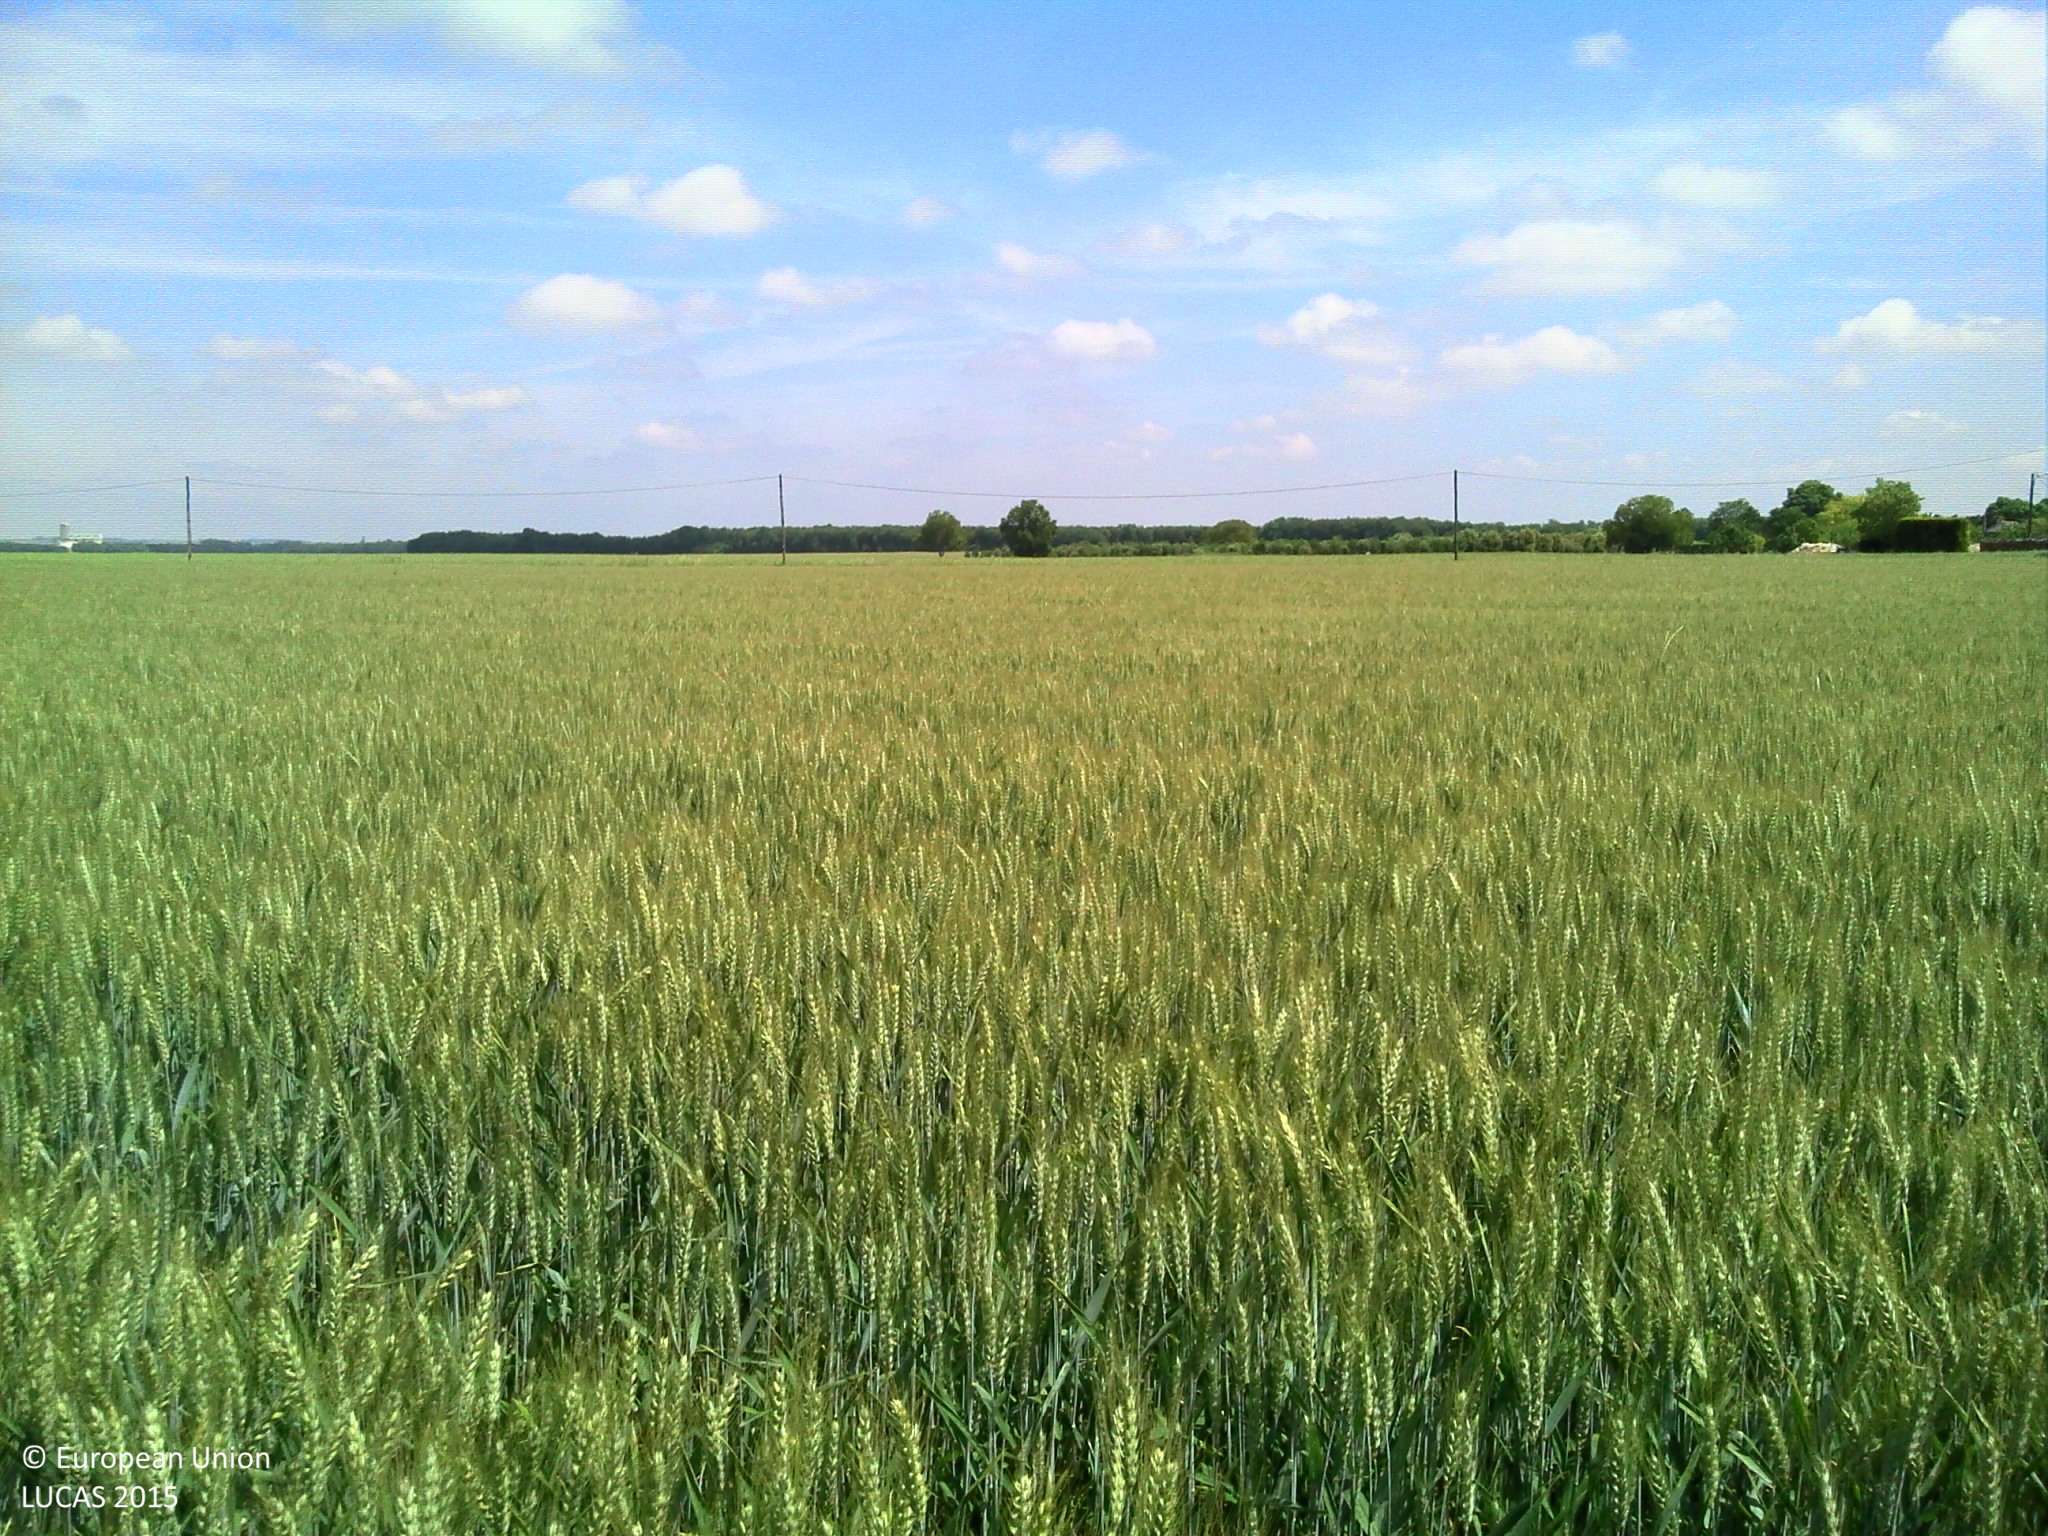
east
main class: Cropland
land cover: Durum wheat
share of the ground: > 75 %
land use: Agriculture (excluding fallow land and kitchen gardens)
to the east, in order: Durum wheat; Grass margins; Paved roads, cycling and walking lanes; Grass margins; Electric lines; Grass margins; Common wheat
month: May
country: FR
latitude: 47.0532
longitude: 0.1170
